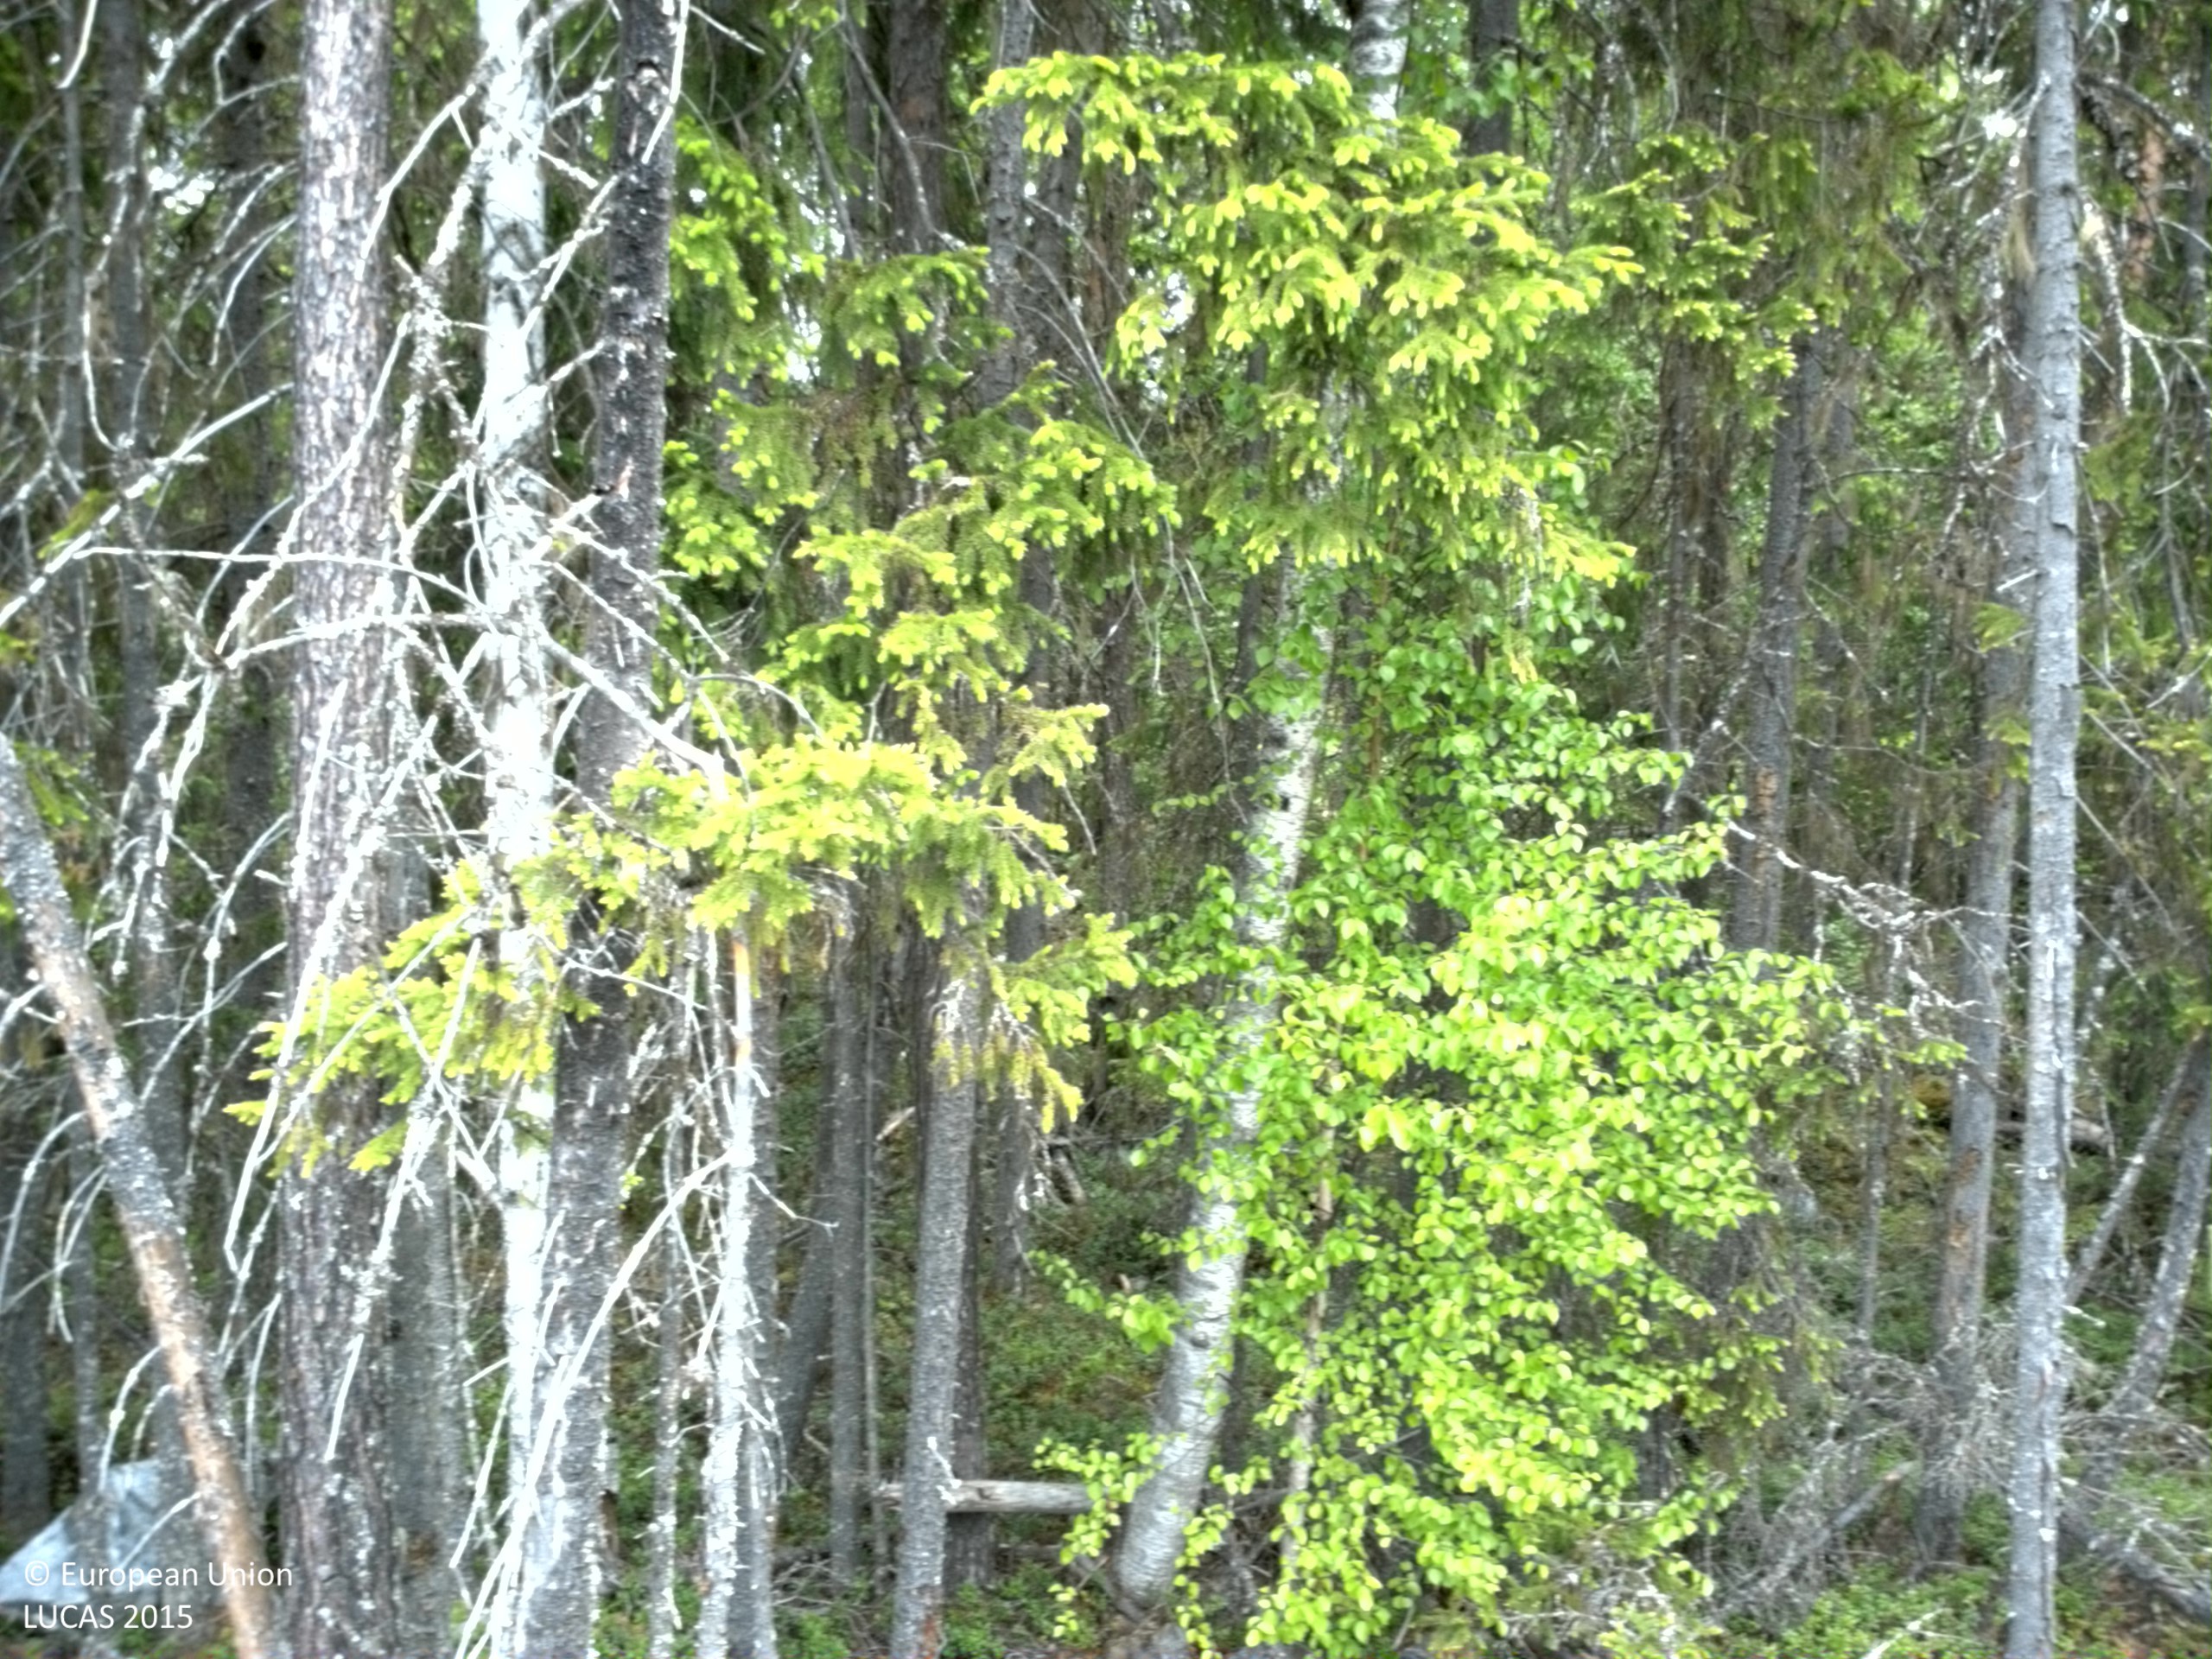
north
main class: Woodland
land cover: Broadleaved woodland
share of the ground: > 75 %
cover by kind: broadleaved forest trees 75 %, shrubs 15 %, coniferous forest trees 5 %, lichens and mosses 5 %
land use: Forestry
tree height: < 5 m
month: June
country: SE
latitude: 63.1707
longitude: 17.8212
